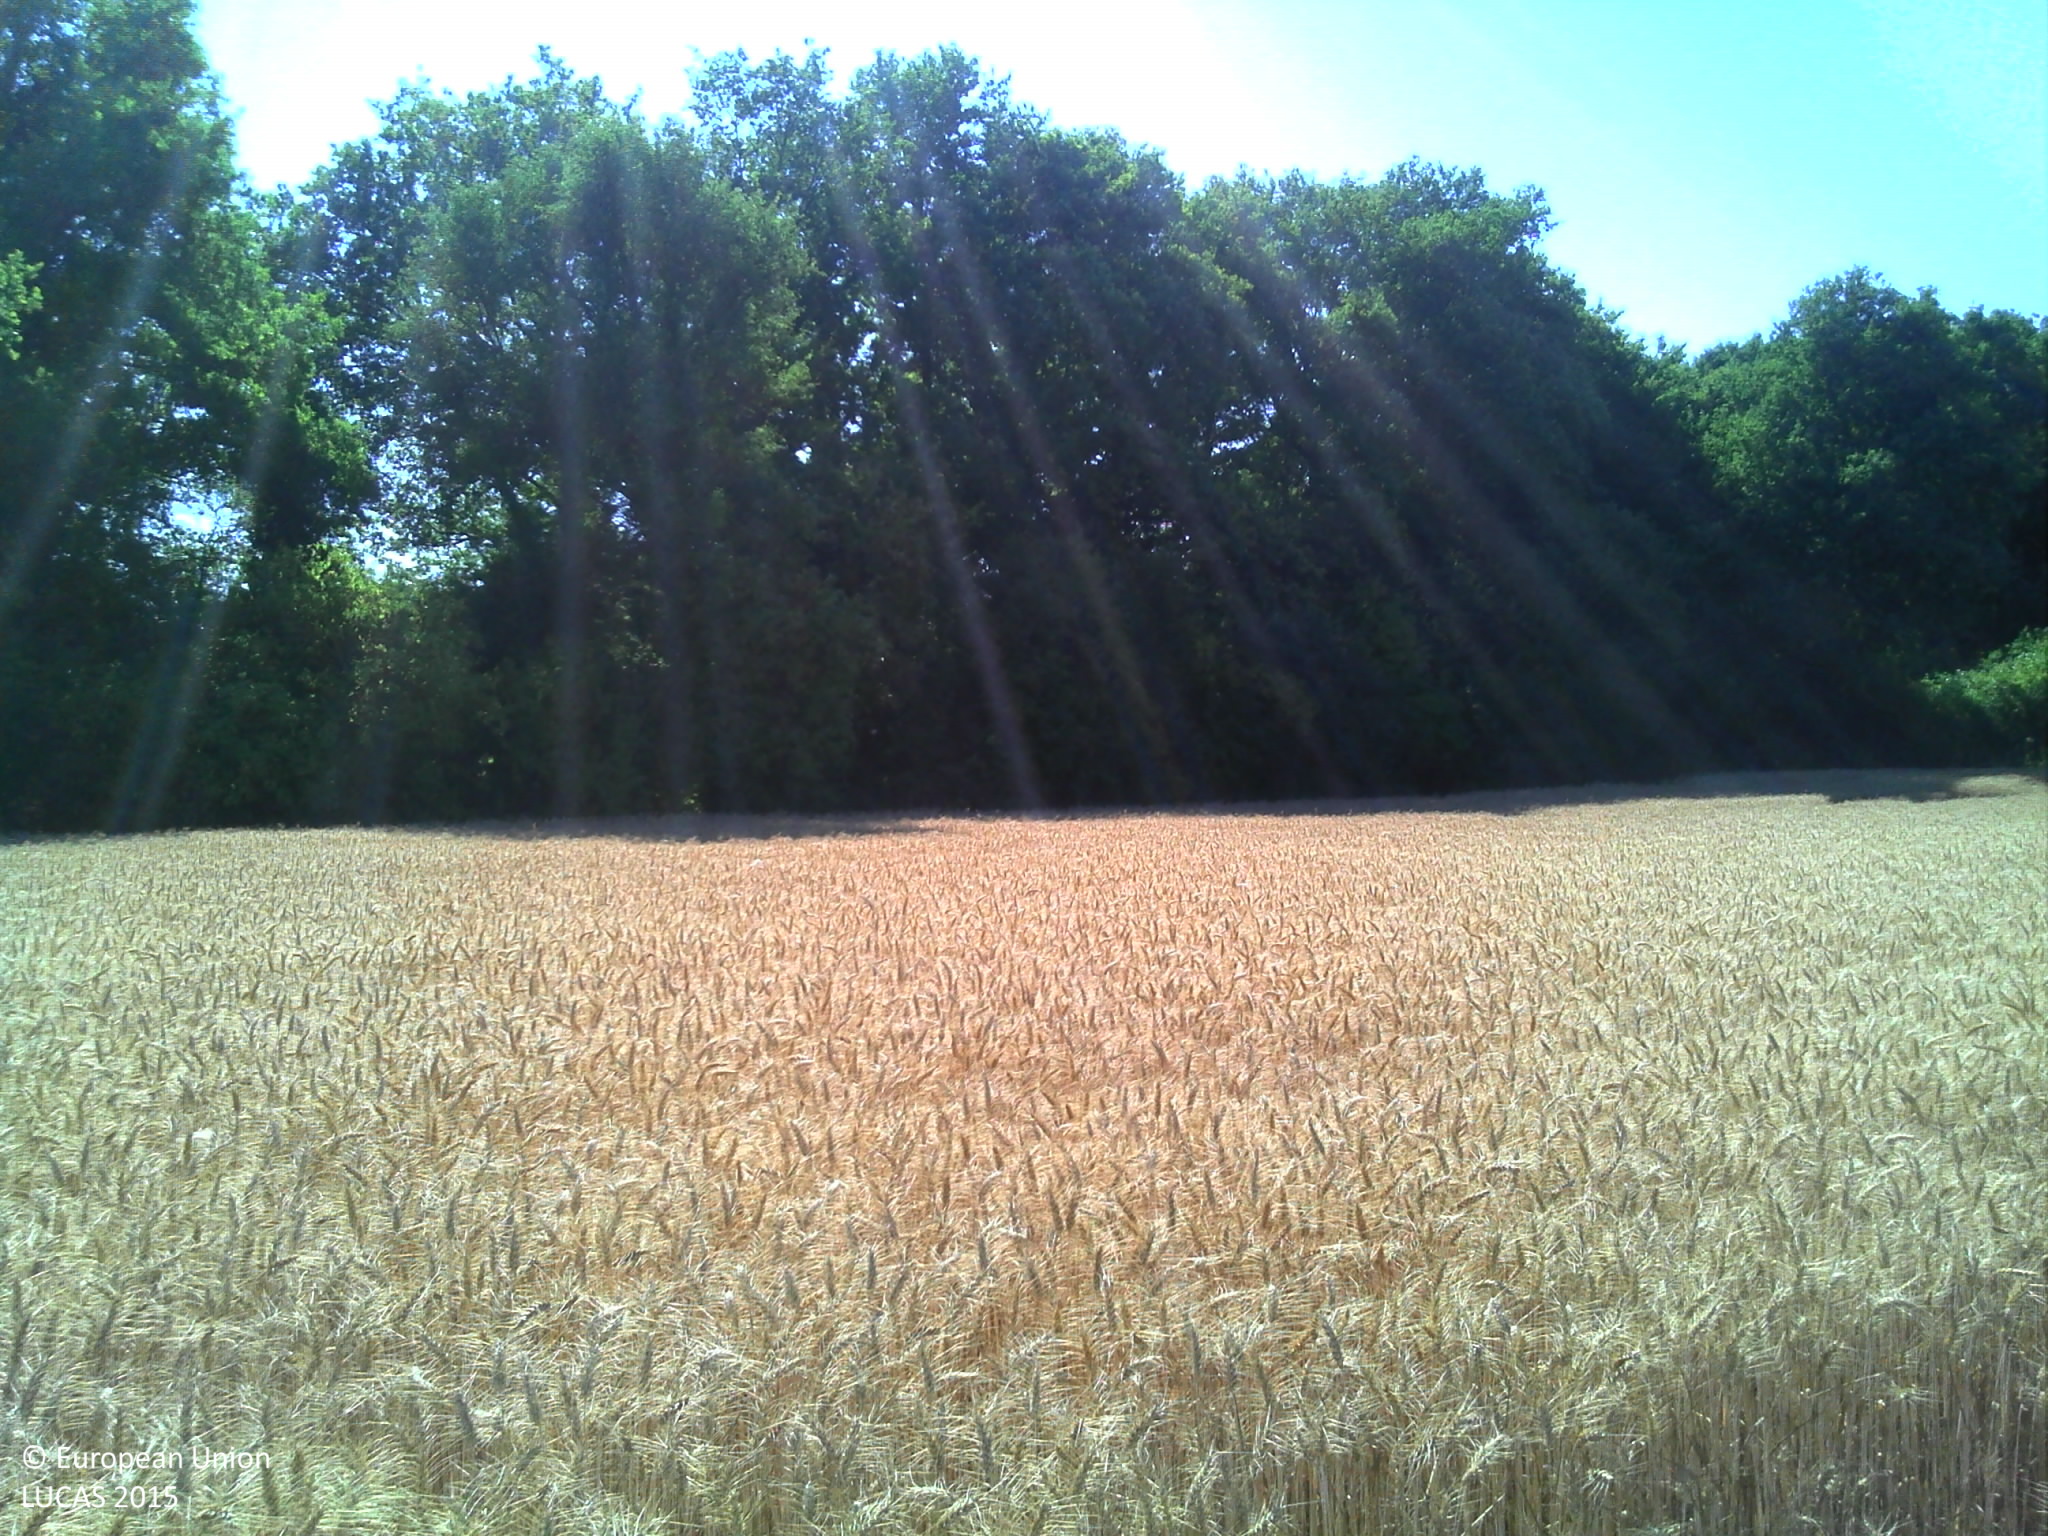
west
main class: Cropland
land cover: Common wheat
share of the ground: > 75 %
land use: Agriculture (excluding fallow land and kitchen gardens)
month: July
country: FR
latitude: 47.9126
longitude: 2.4845
